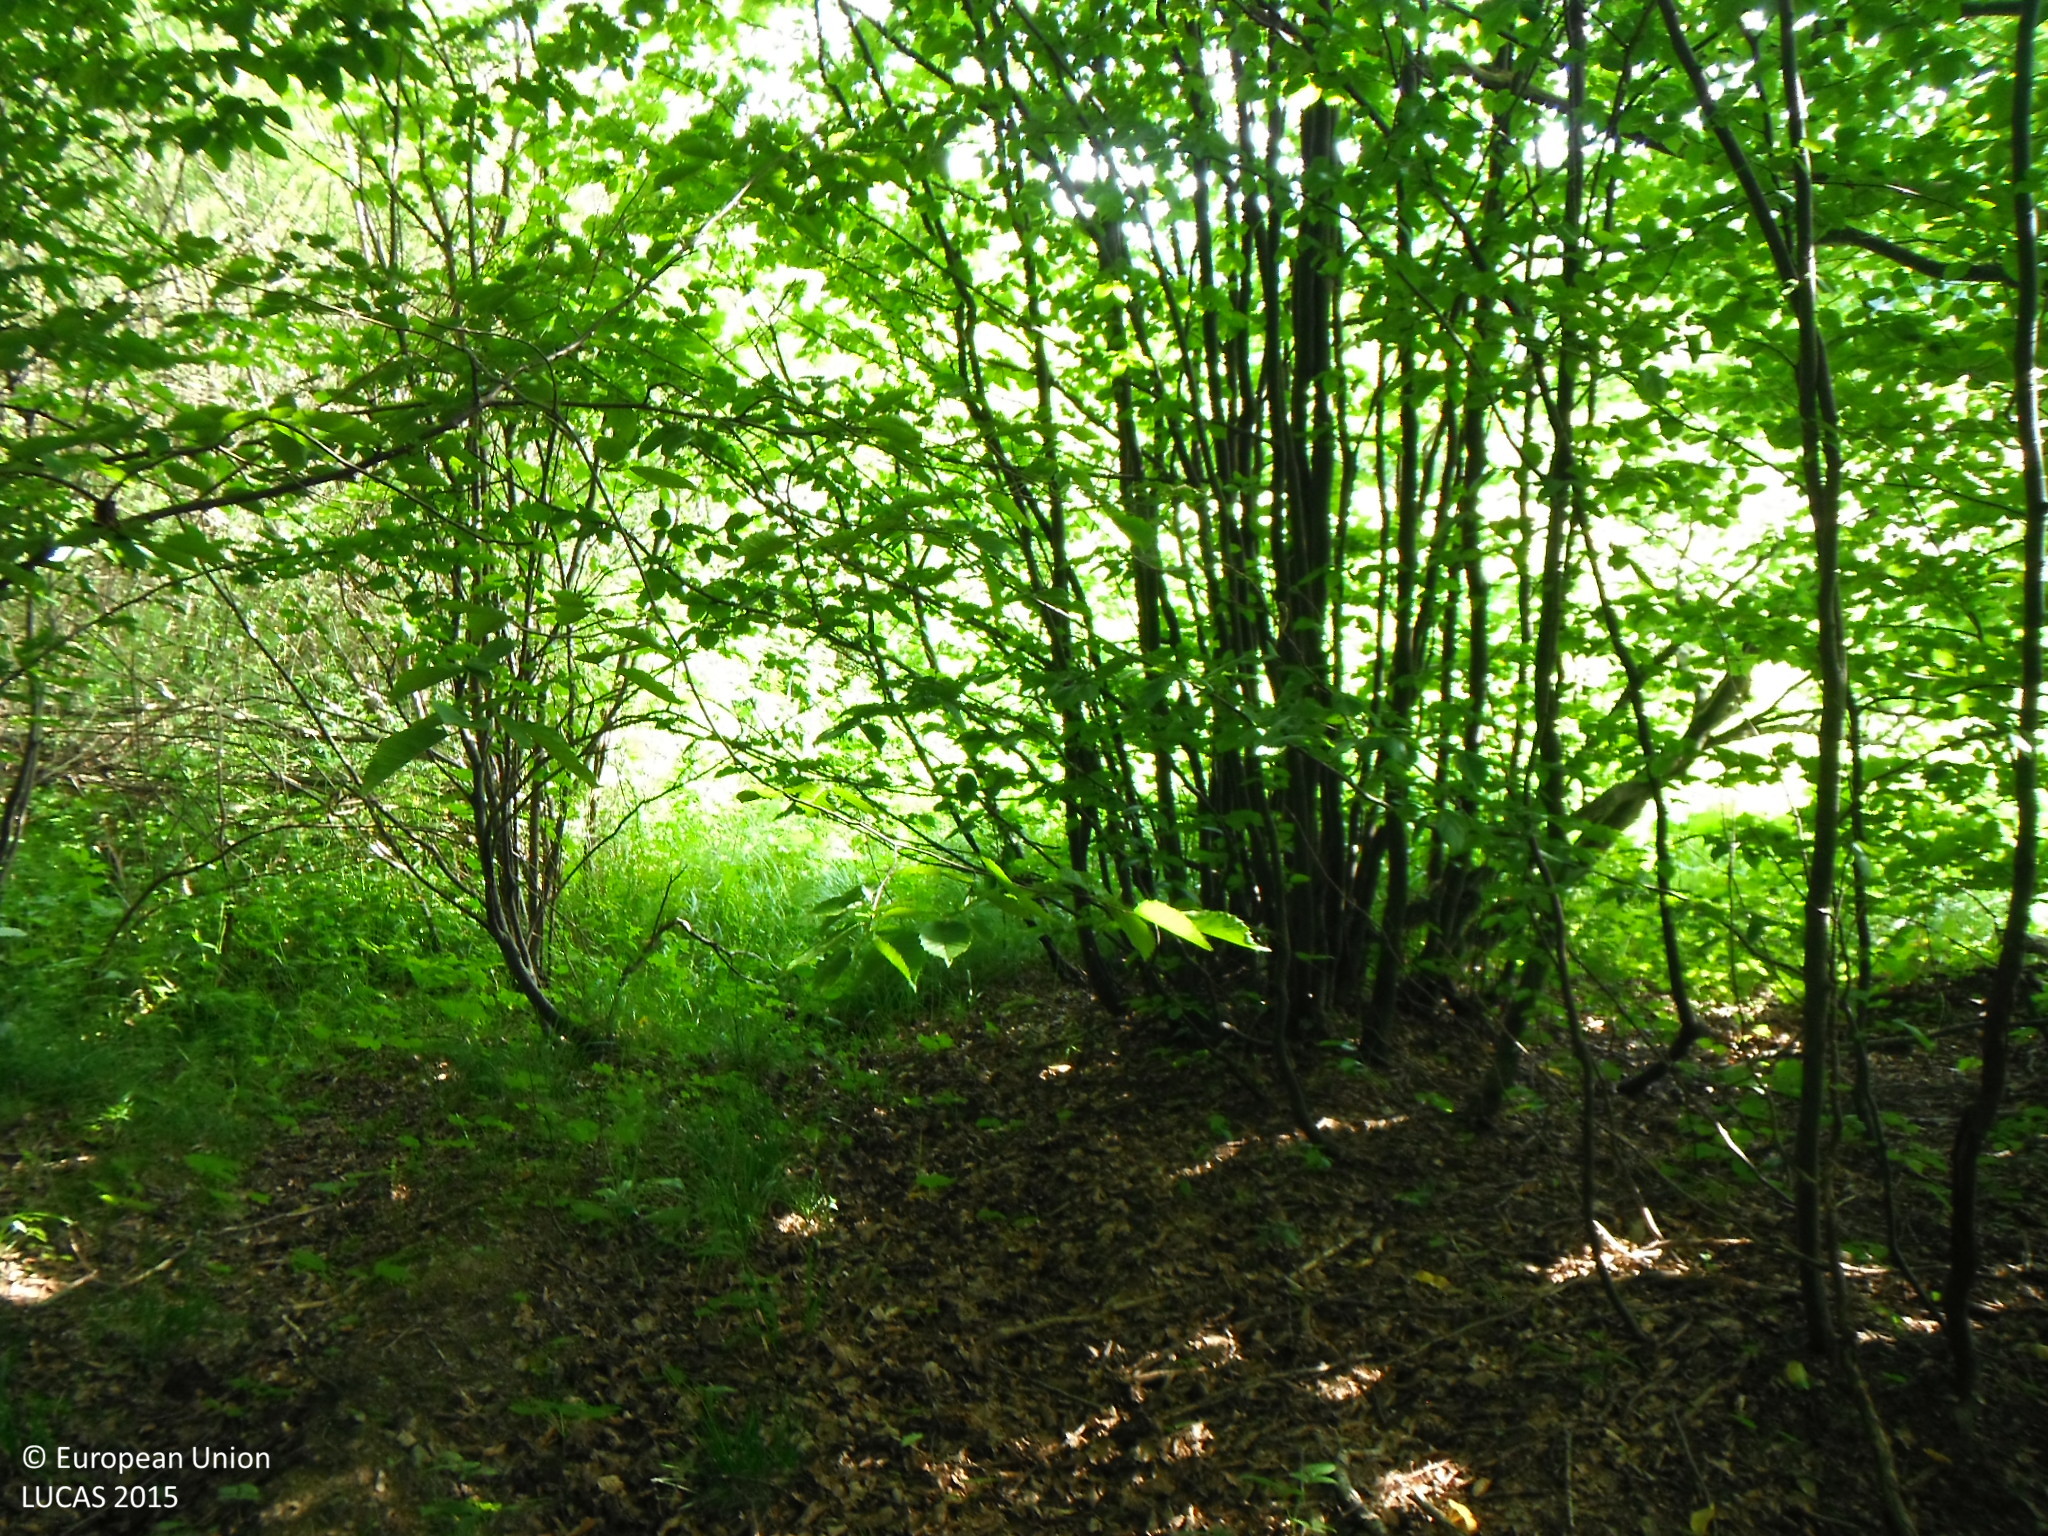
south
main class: Woodland
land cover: Broadleaved woodland
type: beech forest
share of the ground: > 75 %
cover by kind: broadleaved forest trees 100 %
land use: Forestry
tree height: > 5 m
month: June
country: SK
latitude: 49.4422
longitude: 21.6222
